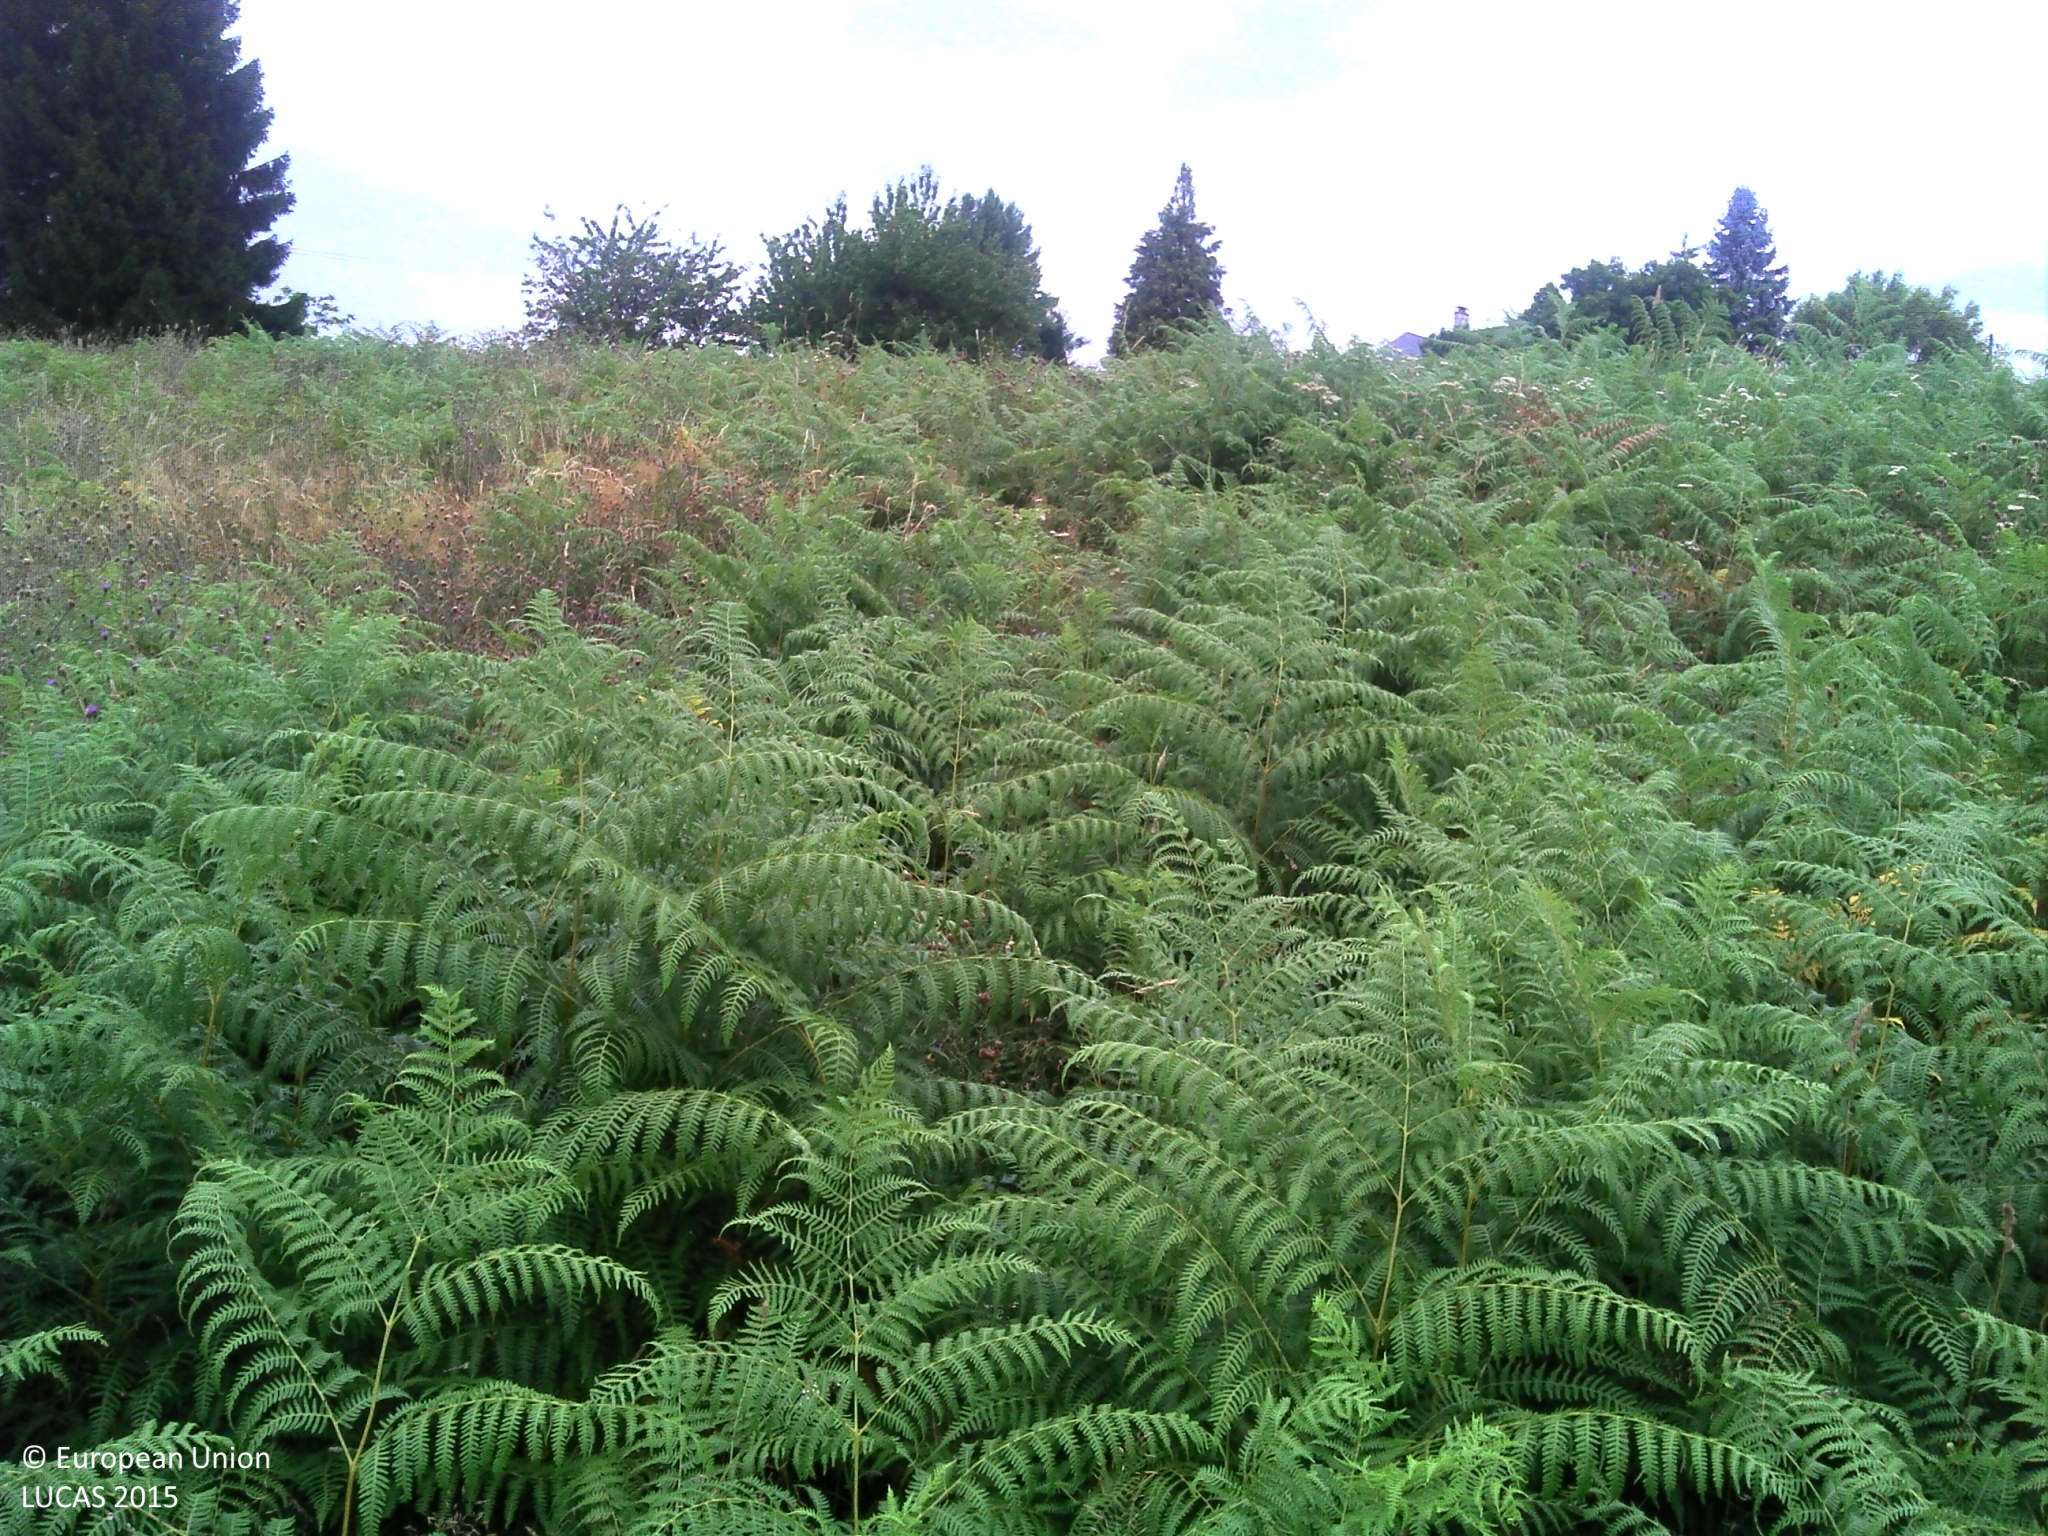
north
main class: Grassland
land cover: Spontaneously vegetated surfaces
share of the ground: > 75 %
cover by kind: herbaceous plants 95 %, shrubs 5 %
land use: Semi-natural and natural areas not in use
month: July
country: FR
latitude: 45.3463
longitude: 1.3272
